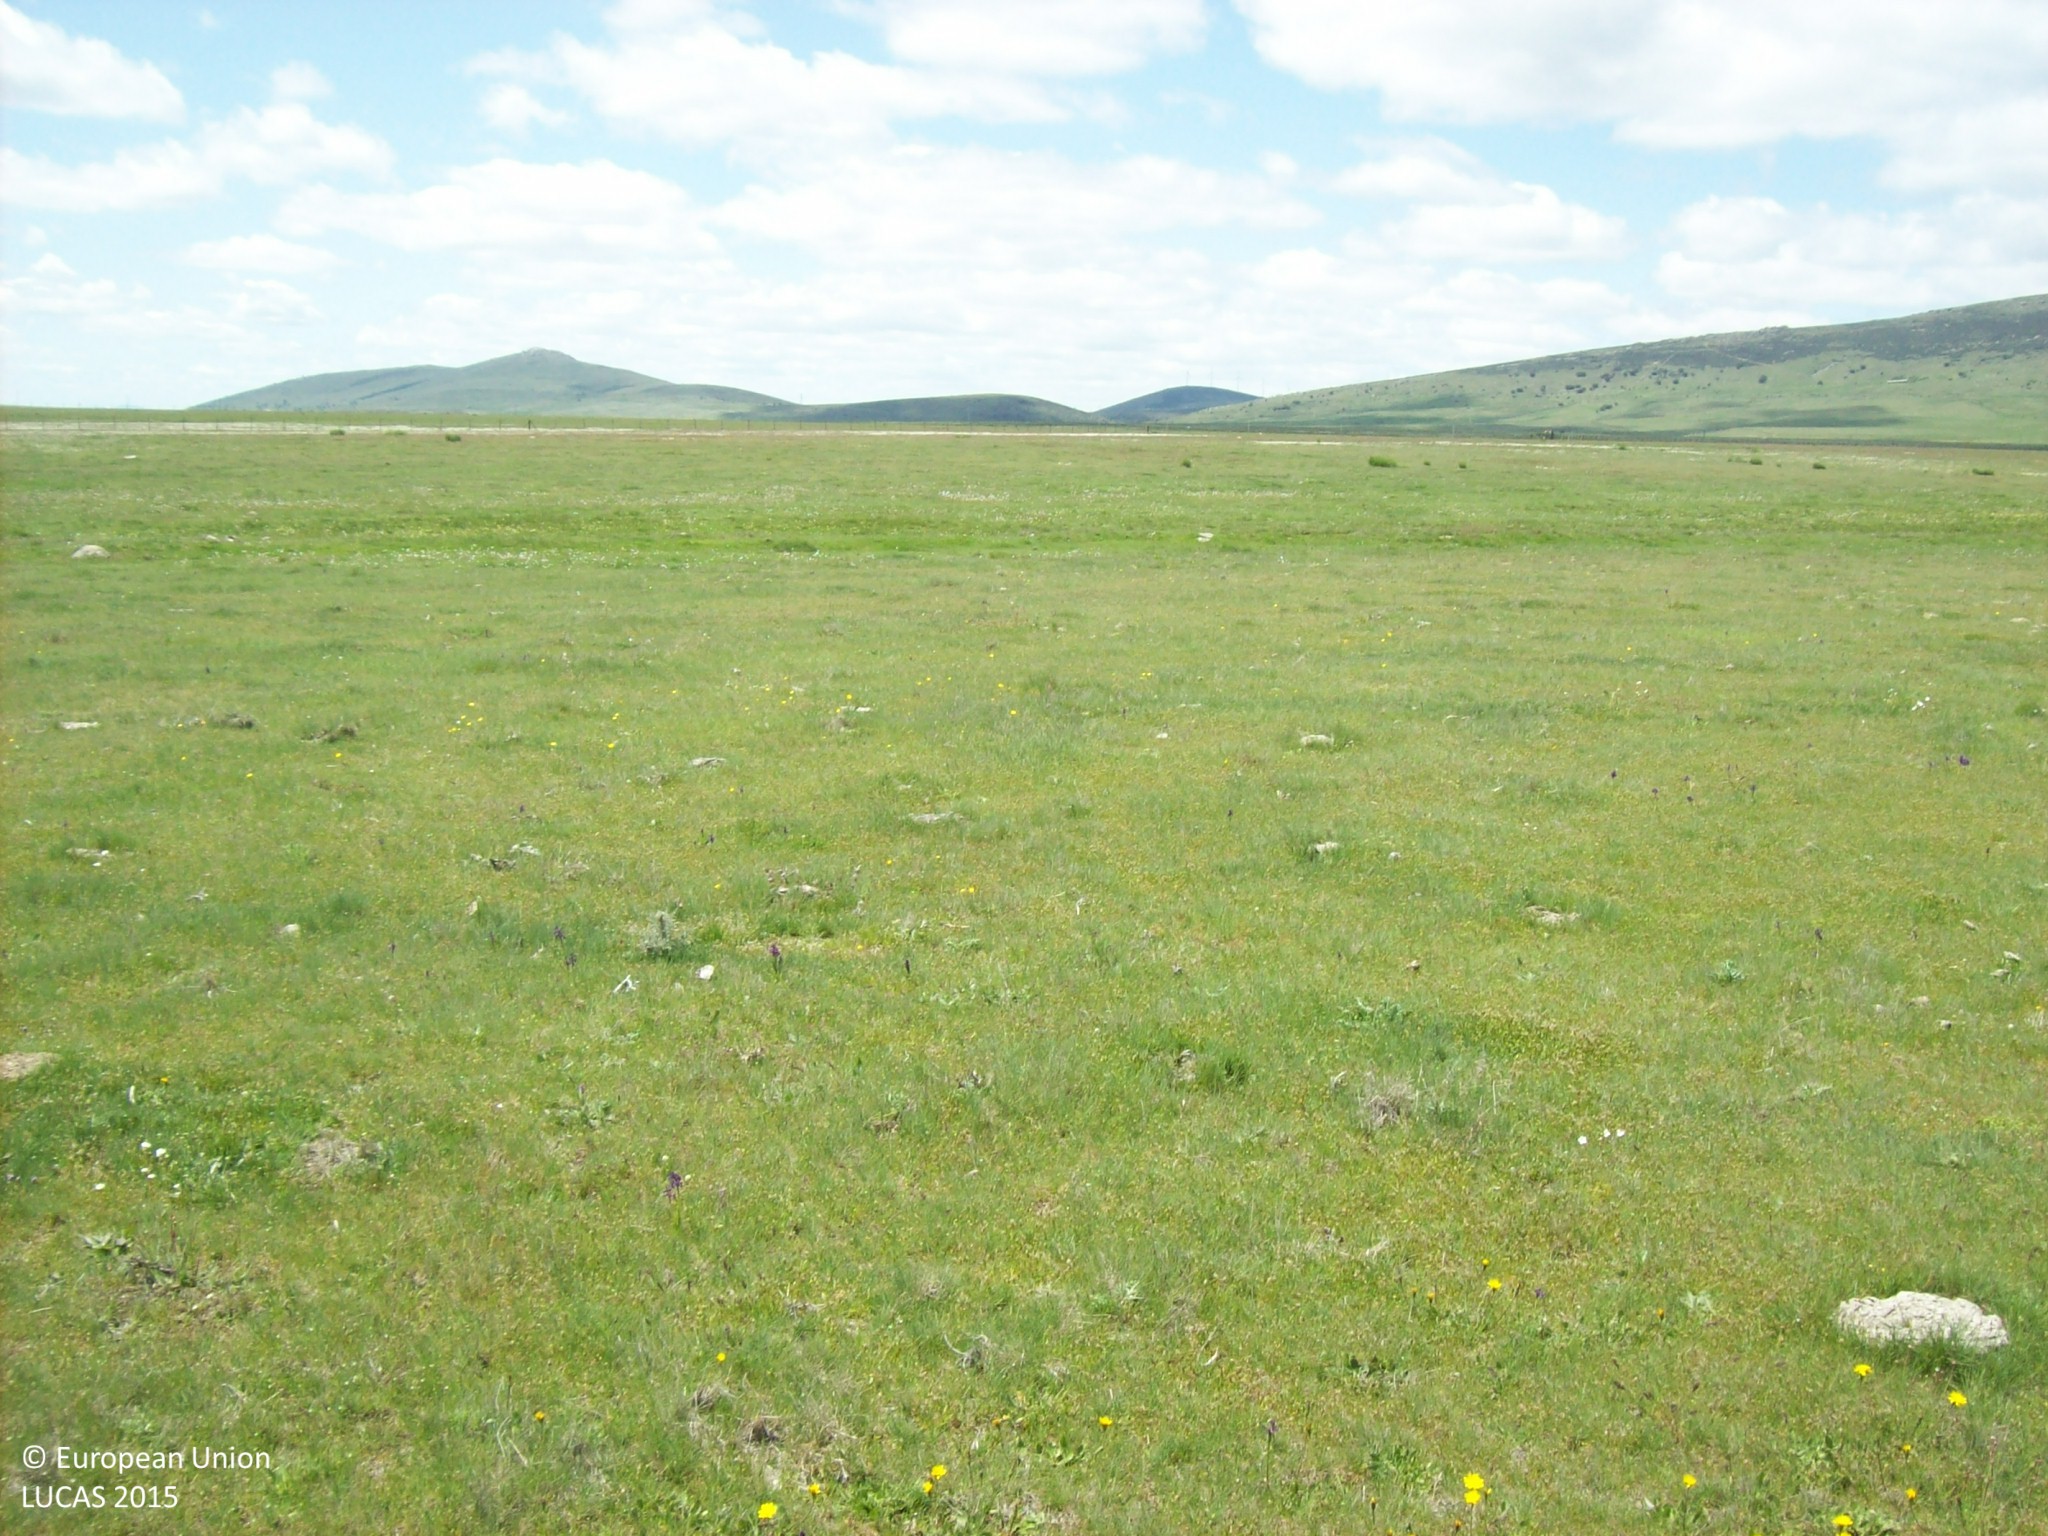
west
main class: Grassland
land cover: Grassland without tree/shrub cover
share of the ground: > 75 %
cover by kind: herbaceous plants 100 %
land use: Agriculture (excluding fallow land and kitchen gardens)
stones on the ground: < 10 %
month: May
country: ES
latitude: 40.6804
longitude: -4.4268
